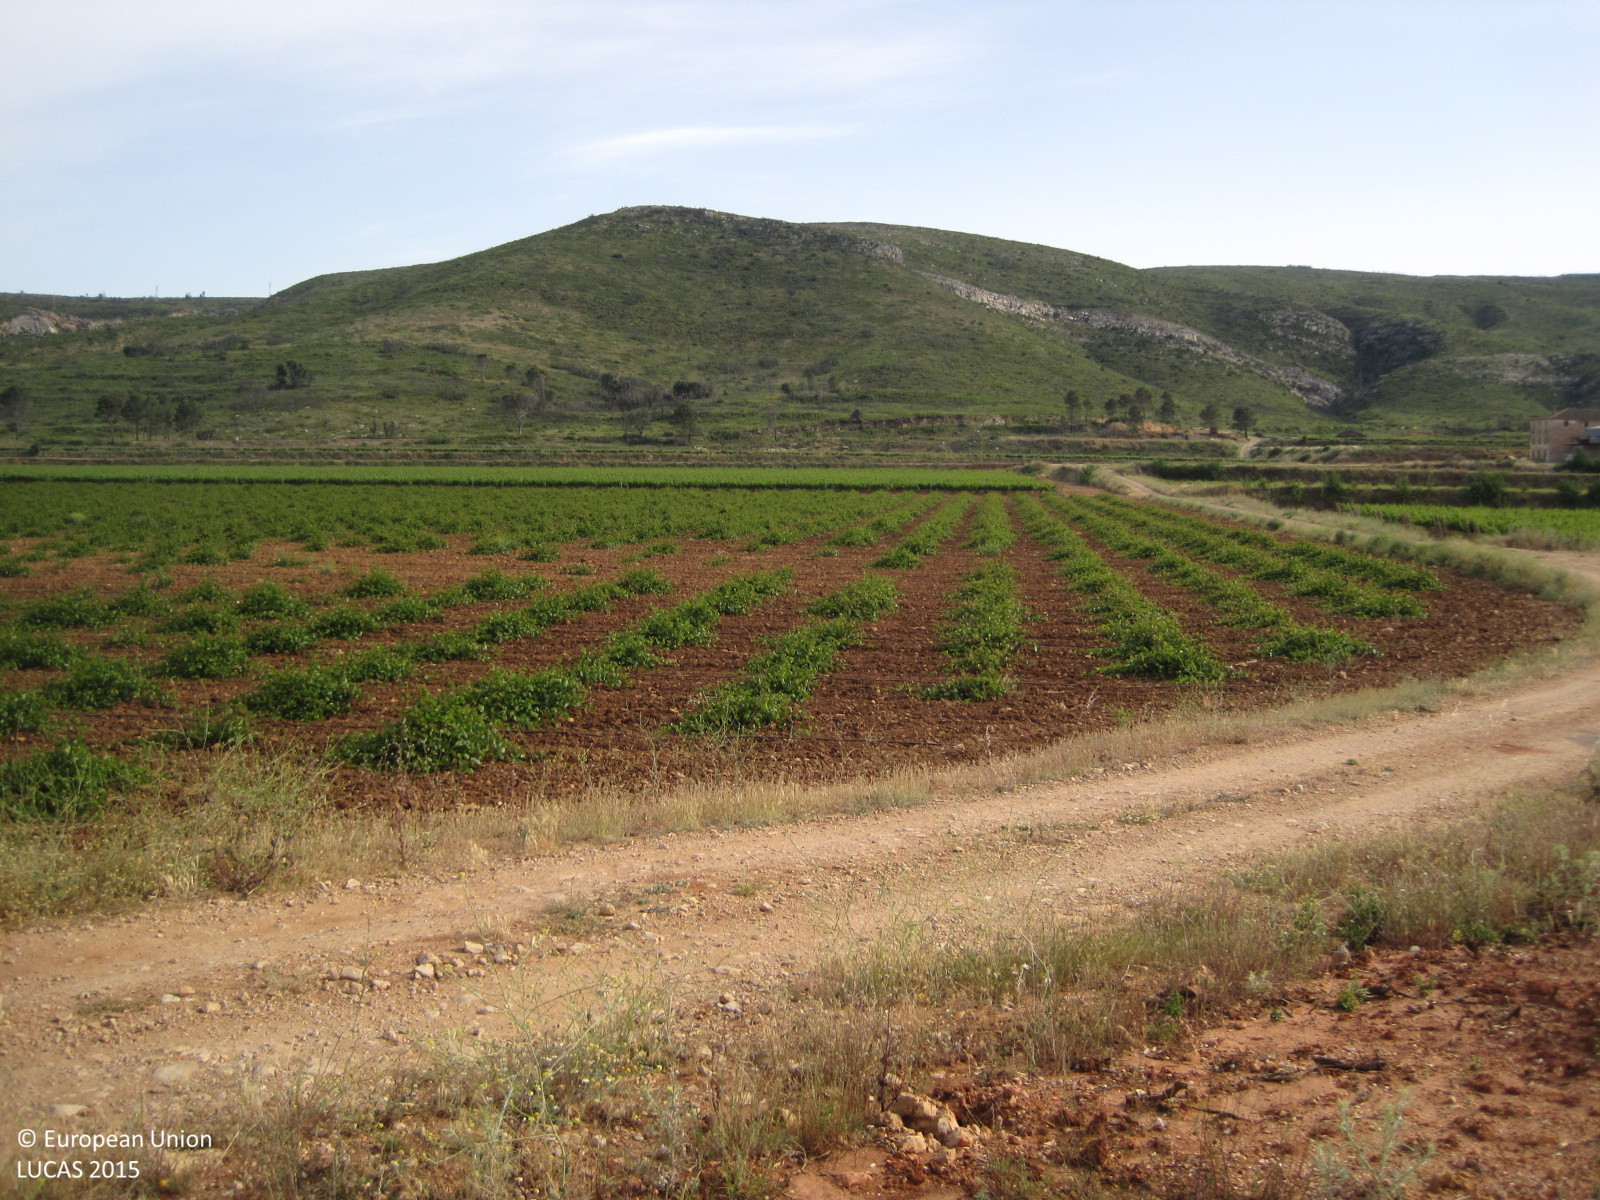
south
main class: Grassland
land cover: Spontaneously vegetated surfaces
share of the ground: 10 - 25 %
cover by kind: unconsolidated bare surface 85 %, herbaceous plants 15 %
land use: Abandoned areas
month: May
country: ES
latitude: 39.3332
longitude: -0.8686
